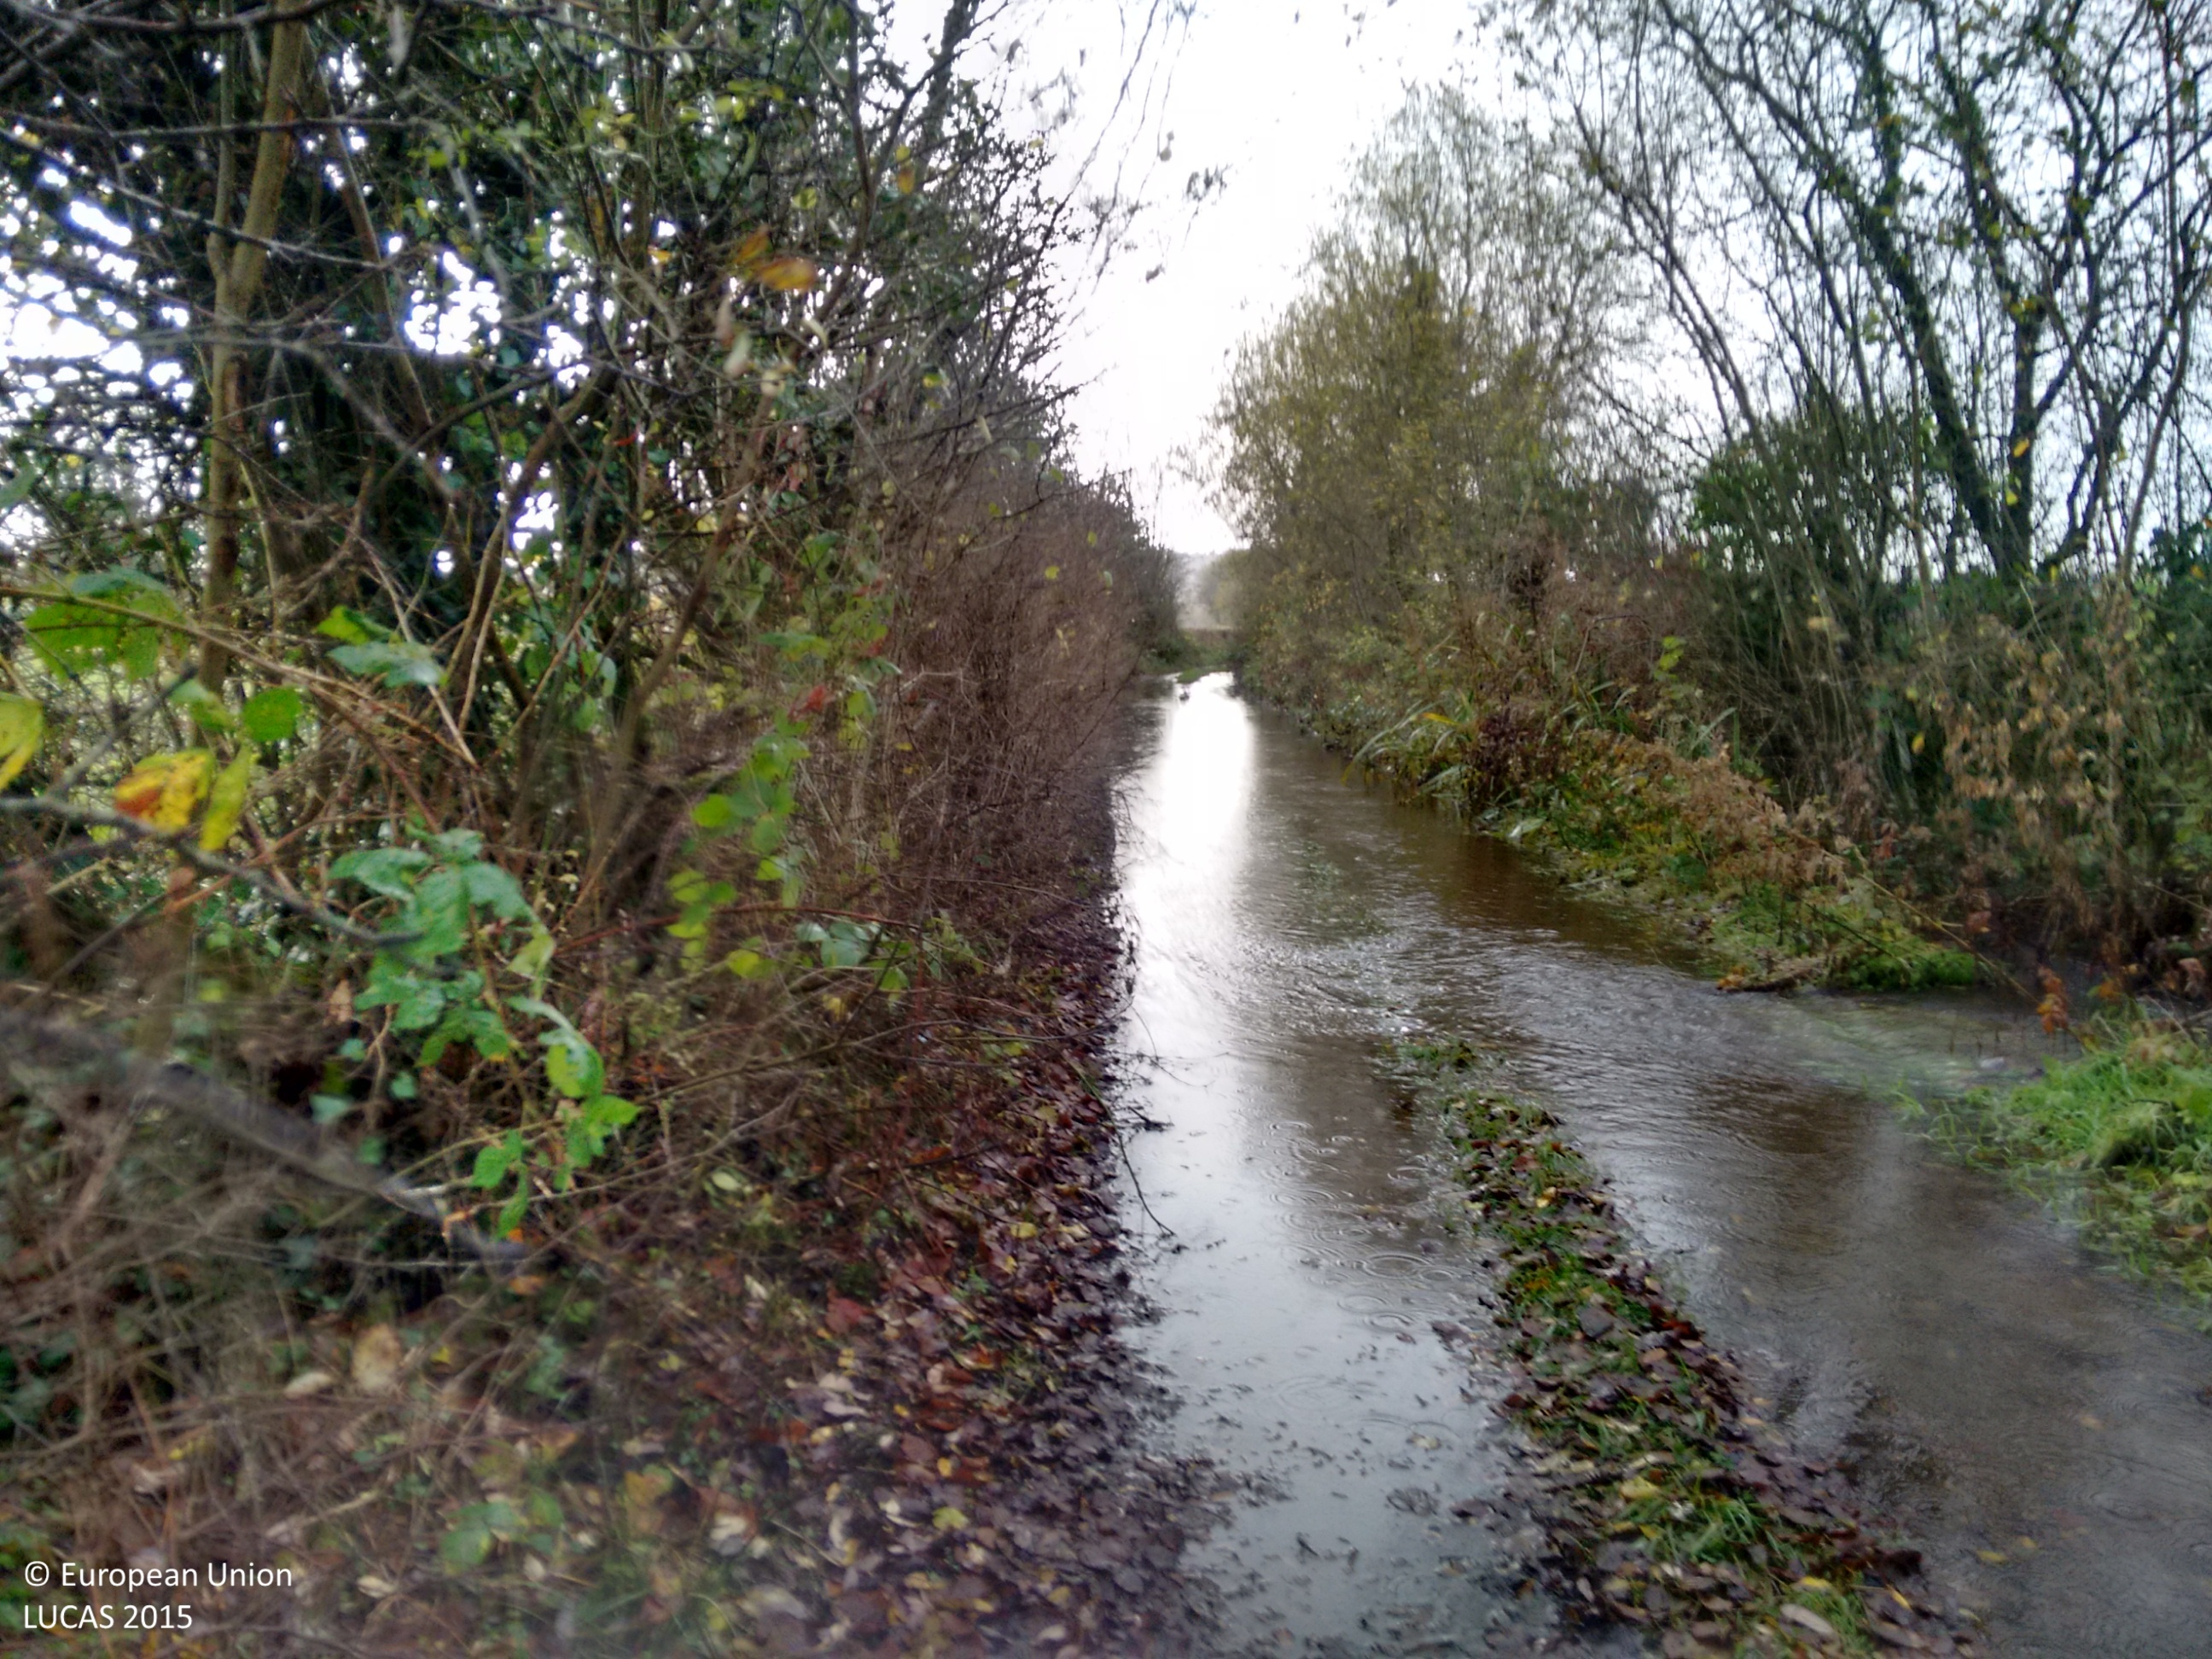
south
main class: Grassland
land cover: Grassland without tree/shrub cover
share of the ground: > 75 %
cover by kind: herbaceous plants 100 %
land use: Agriculture (excluding fallow land and kitchen gardens)
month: November
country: IE
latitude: 53.9446
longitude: -7.9524
